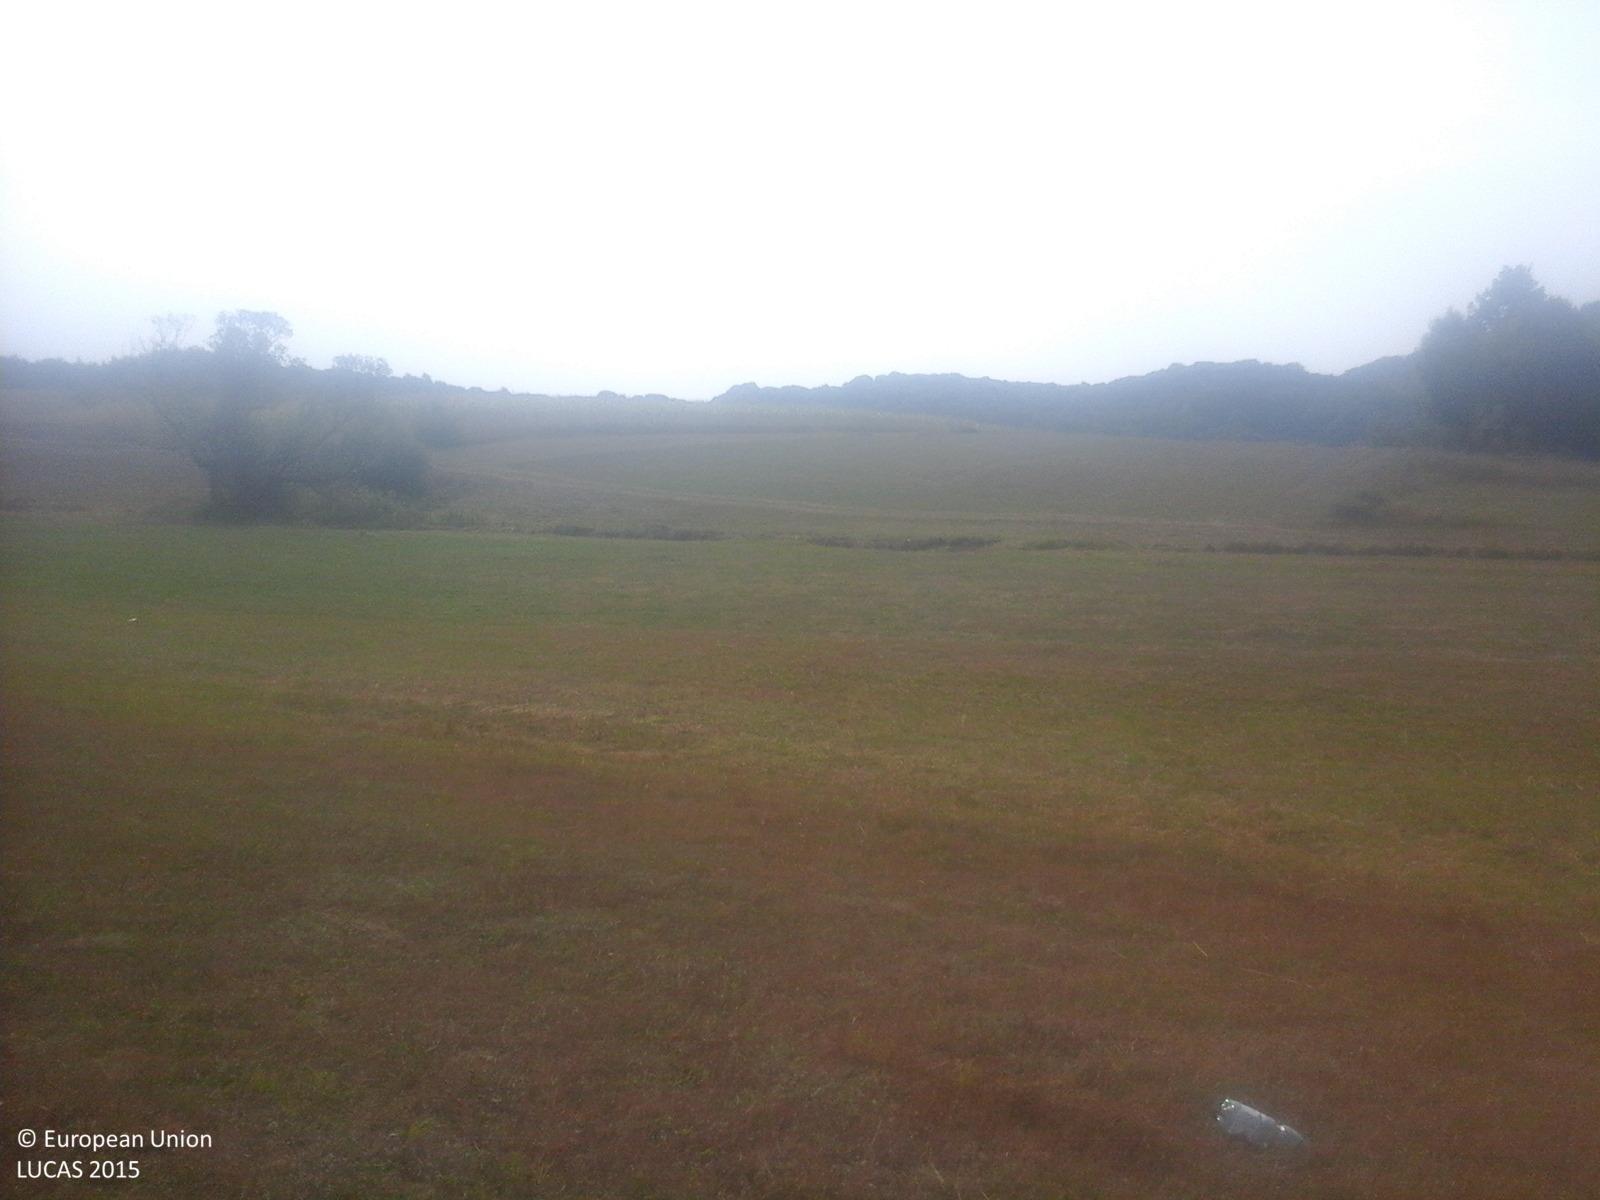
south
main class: Grassland
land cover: Grassland without tree/shrub cover
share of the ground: > 75 %
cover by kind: herbaceous plants 100 %
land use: Agriculture (excluding fallow land and kitchen gardens)
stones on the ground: < 10 %
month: September
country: RO
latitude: 47.4765
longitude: 23.8132
